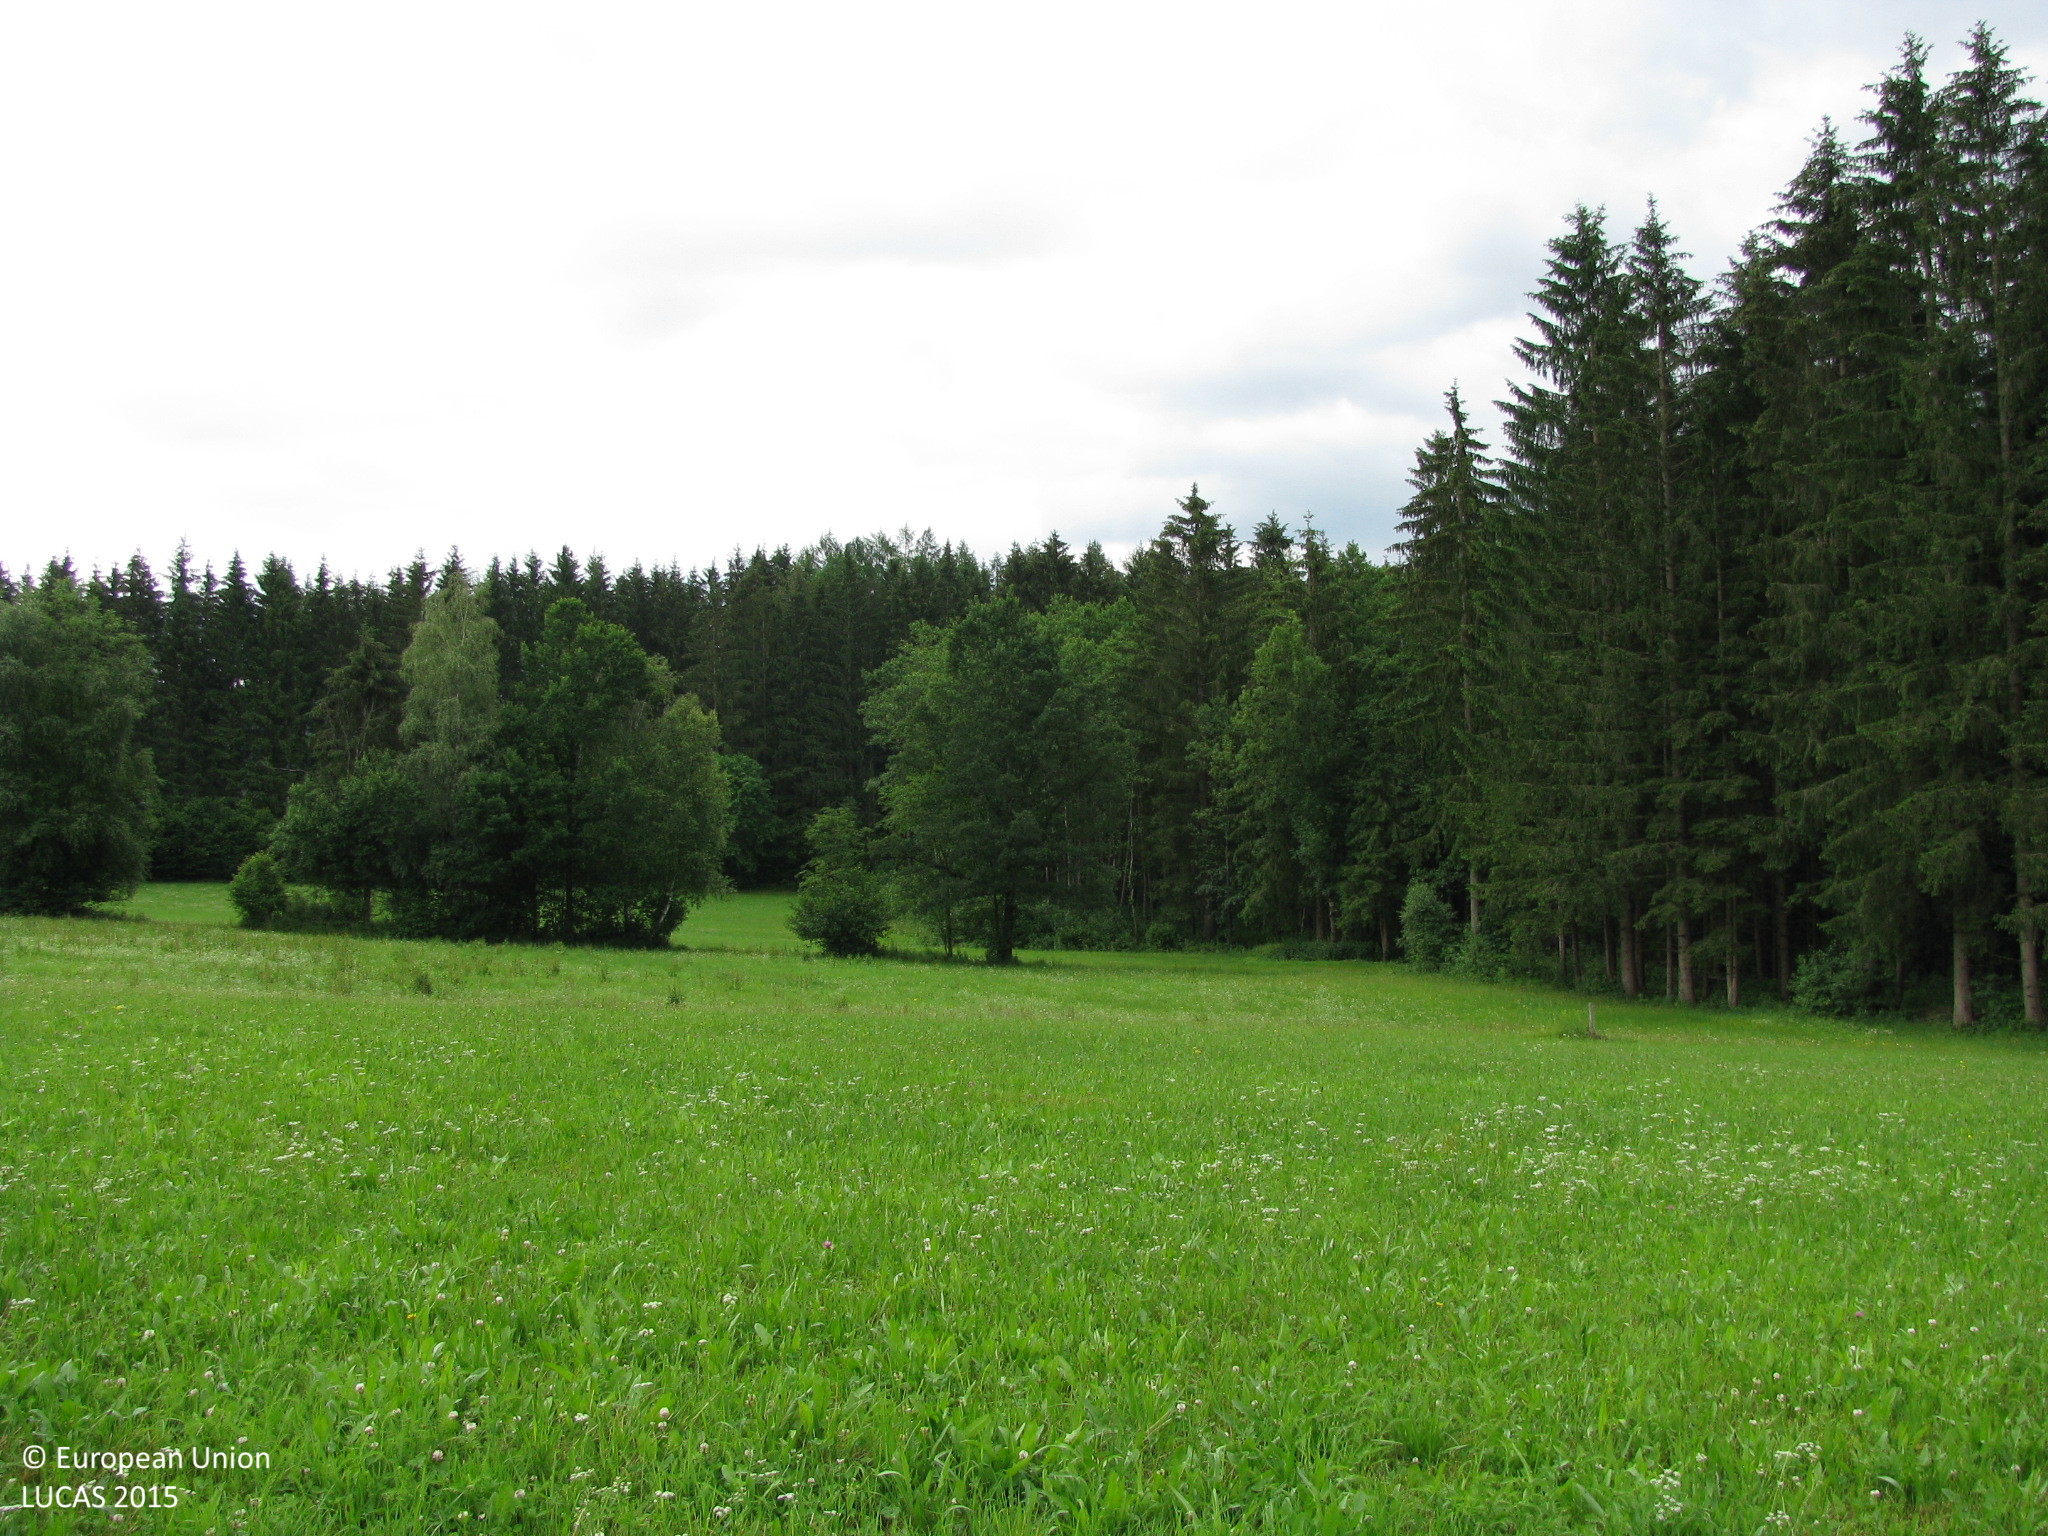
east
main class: Grassland
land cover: Grassland without tree/shrub cover
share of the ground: > 75 %
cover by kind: herbaceous plants 100 %
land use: Agriculture (excluding fallow land and kitchen gardens)
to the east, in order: Grassland without tree/shrub cover; Broadleaved woodland; Grassland without tree/shrub cover; Spruce dominated coniferous woodland; Tracks; Other mixed woodland; Spruce dominated coniferous woodland
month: June
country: AT
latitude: 47.2741
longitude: 14.7446
